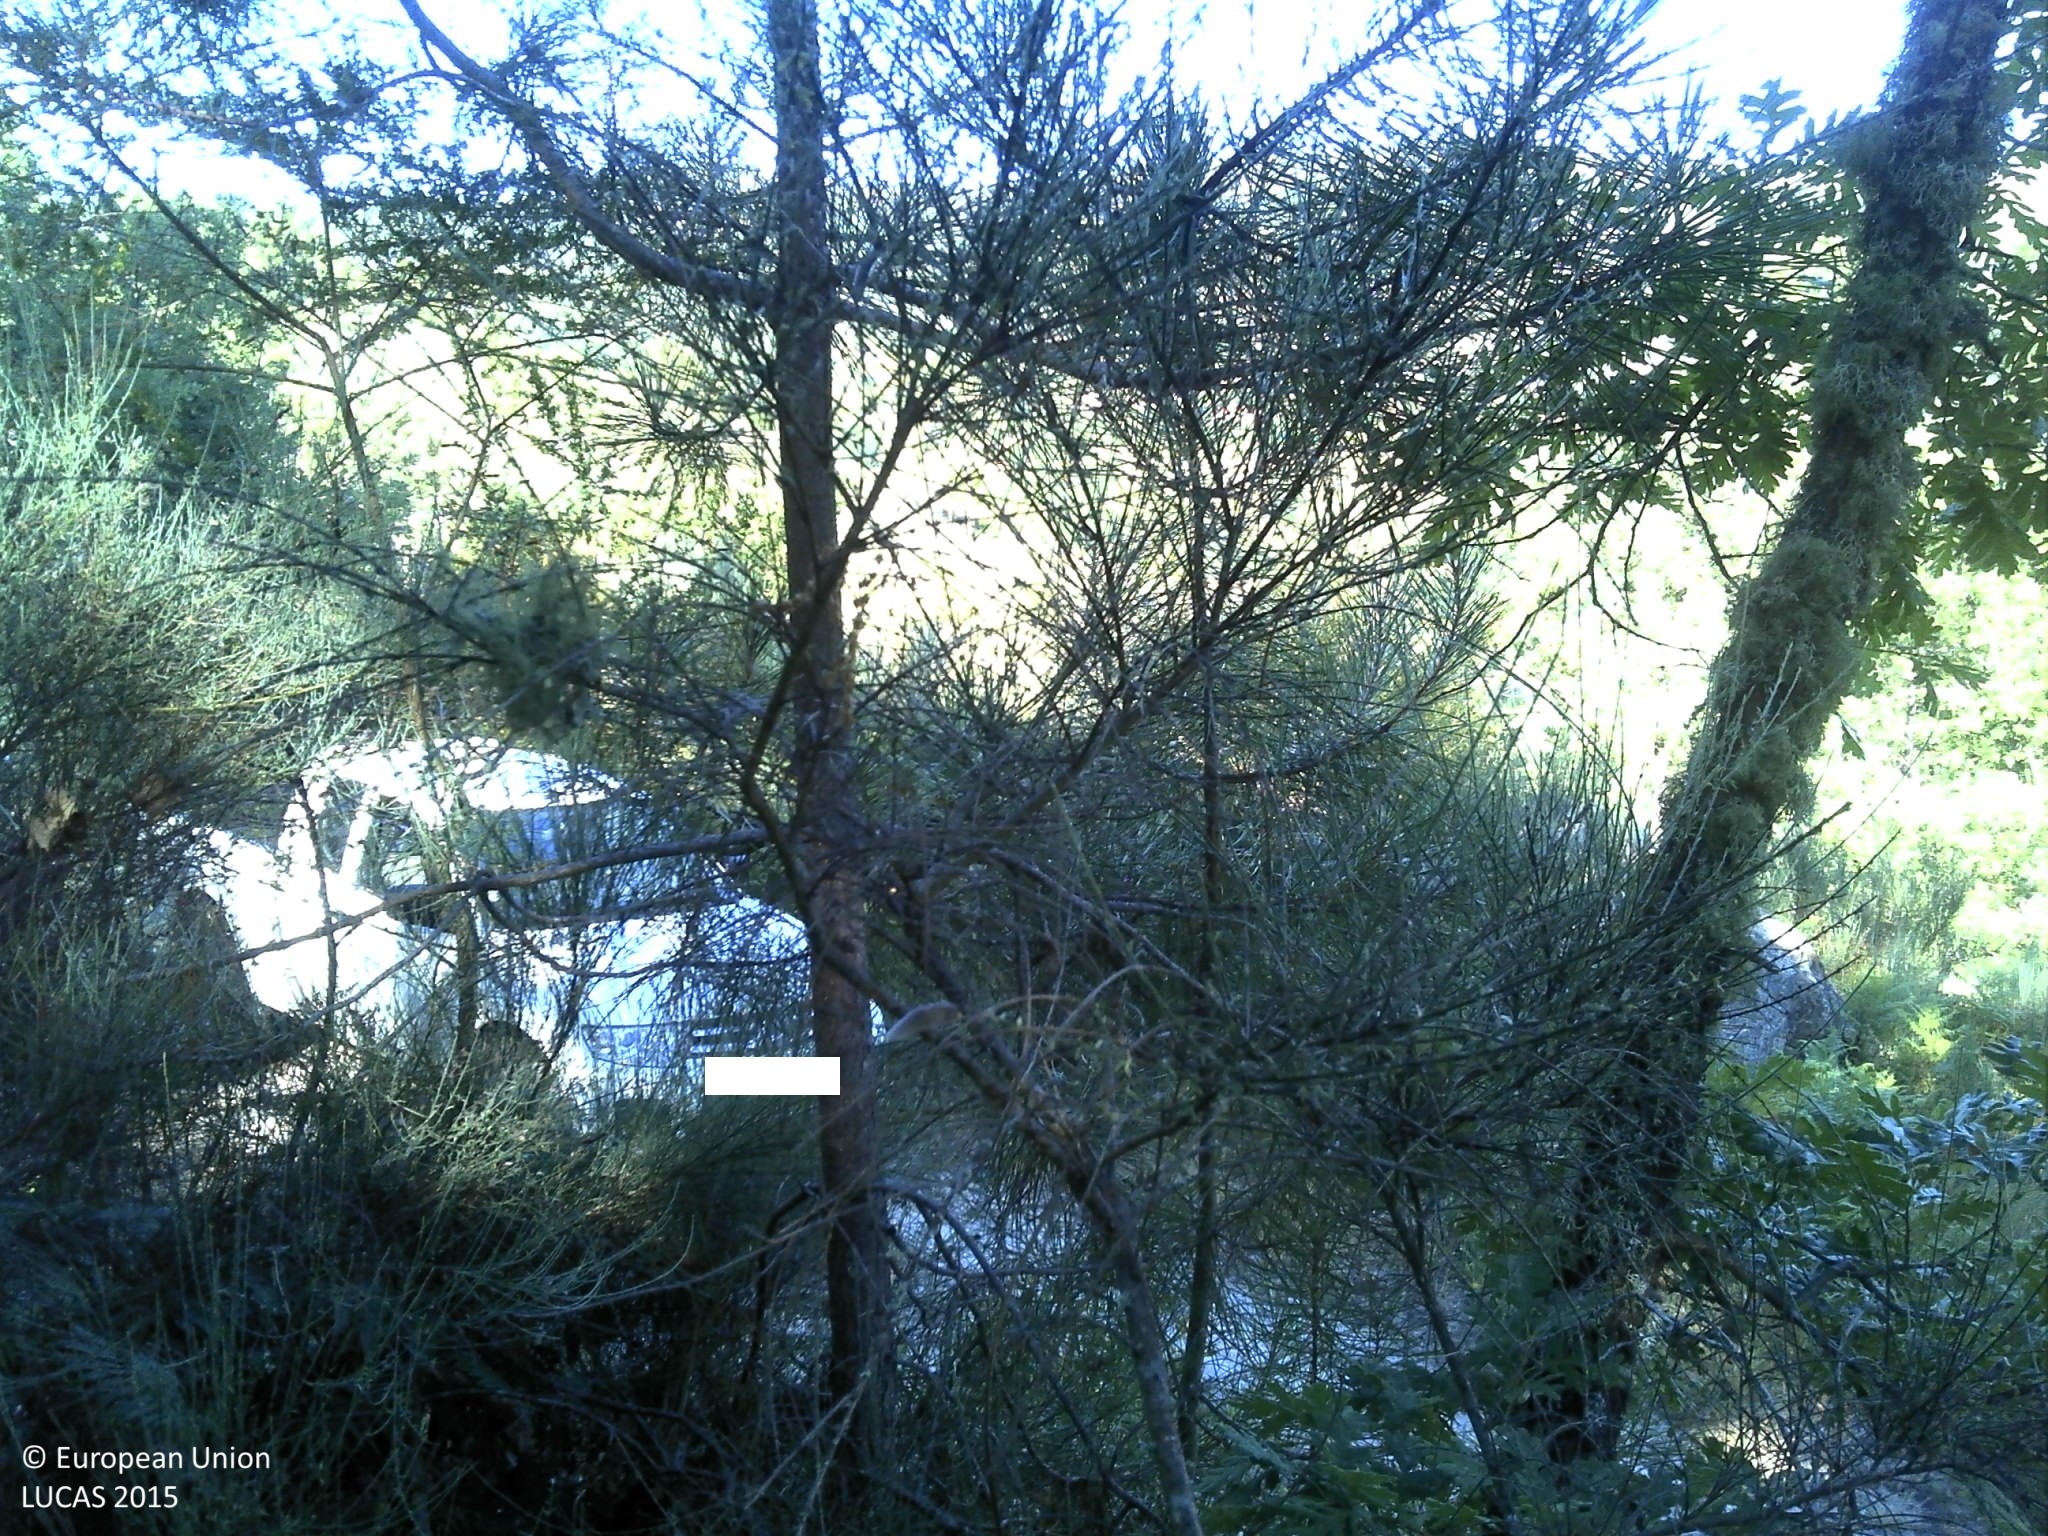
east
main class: Woodland
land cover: Broadleaved woodland
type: thermophilous deciduous forest
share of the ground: > 75 %
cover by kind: broadleaved forest trees 75 %, shrubs 10 %, unconsolidated bare surface 10 %, herbaceous plants 5 %
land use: Forestry
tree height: > 5 m
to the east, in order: Broadleaved woodland; Tracks; Broadleaved woodland; Shrubland without tree cover; Rocks and stones
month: July
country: PT
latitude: 41.6260
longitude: -7.7438
